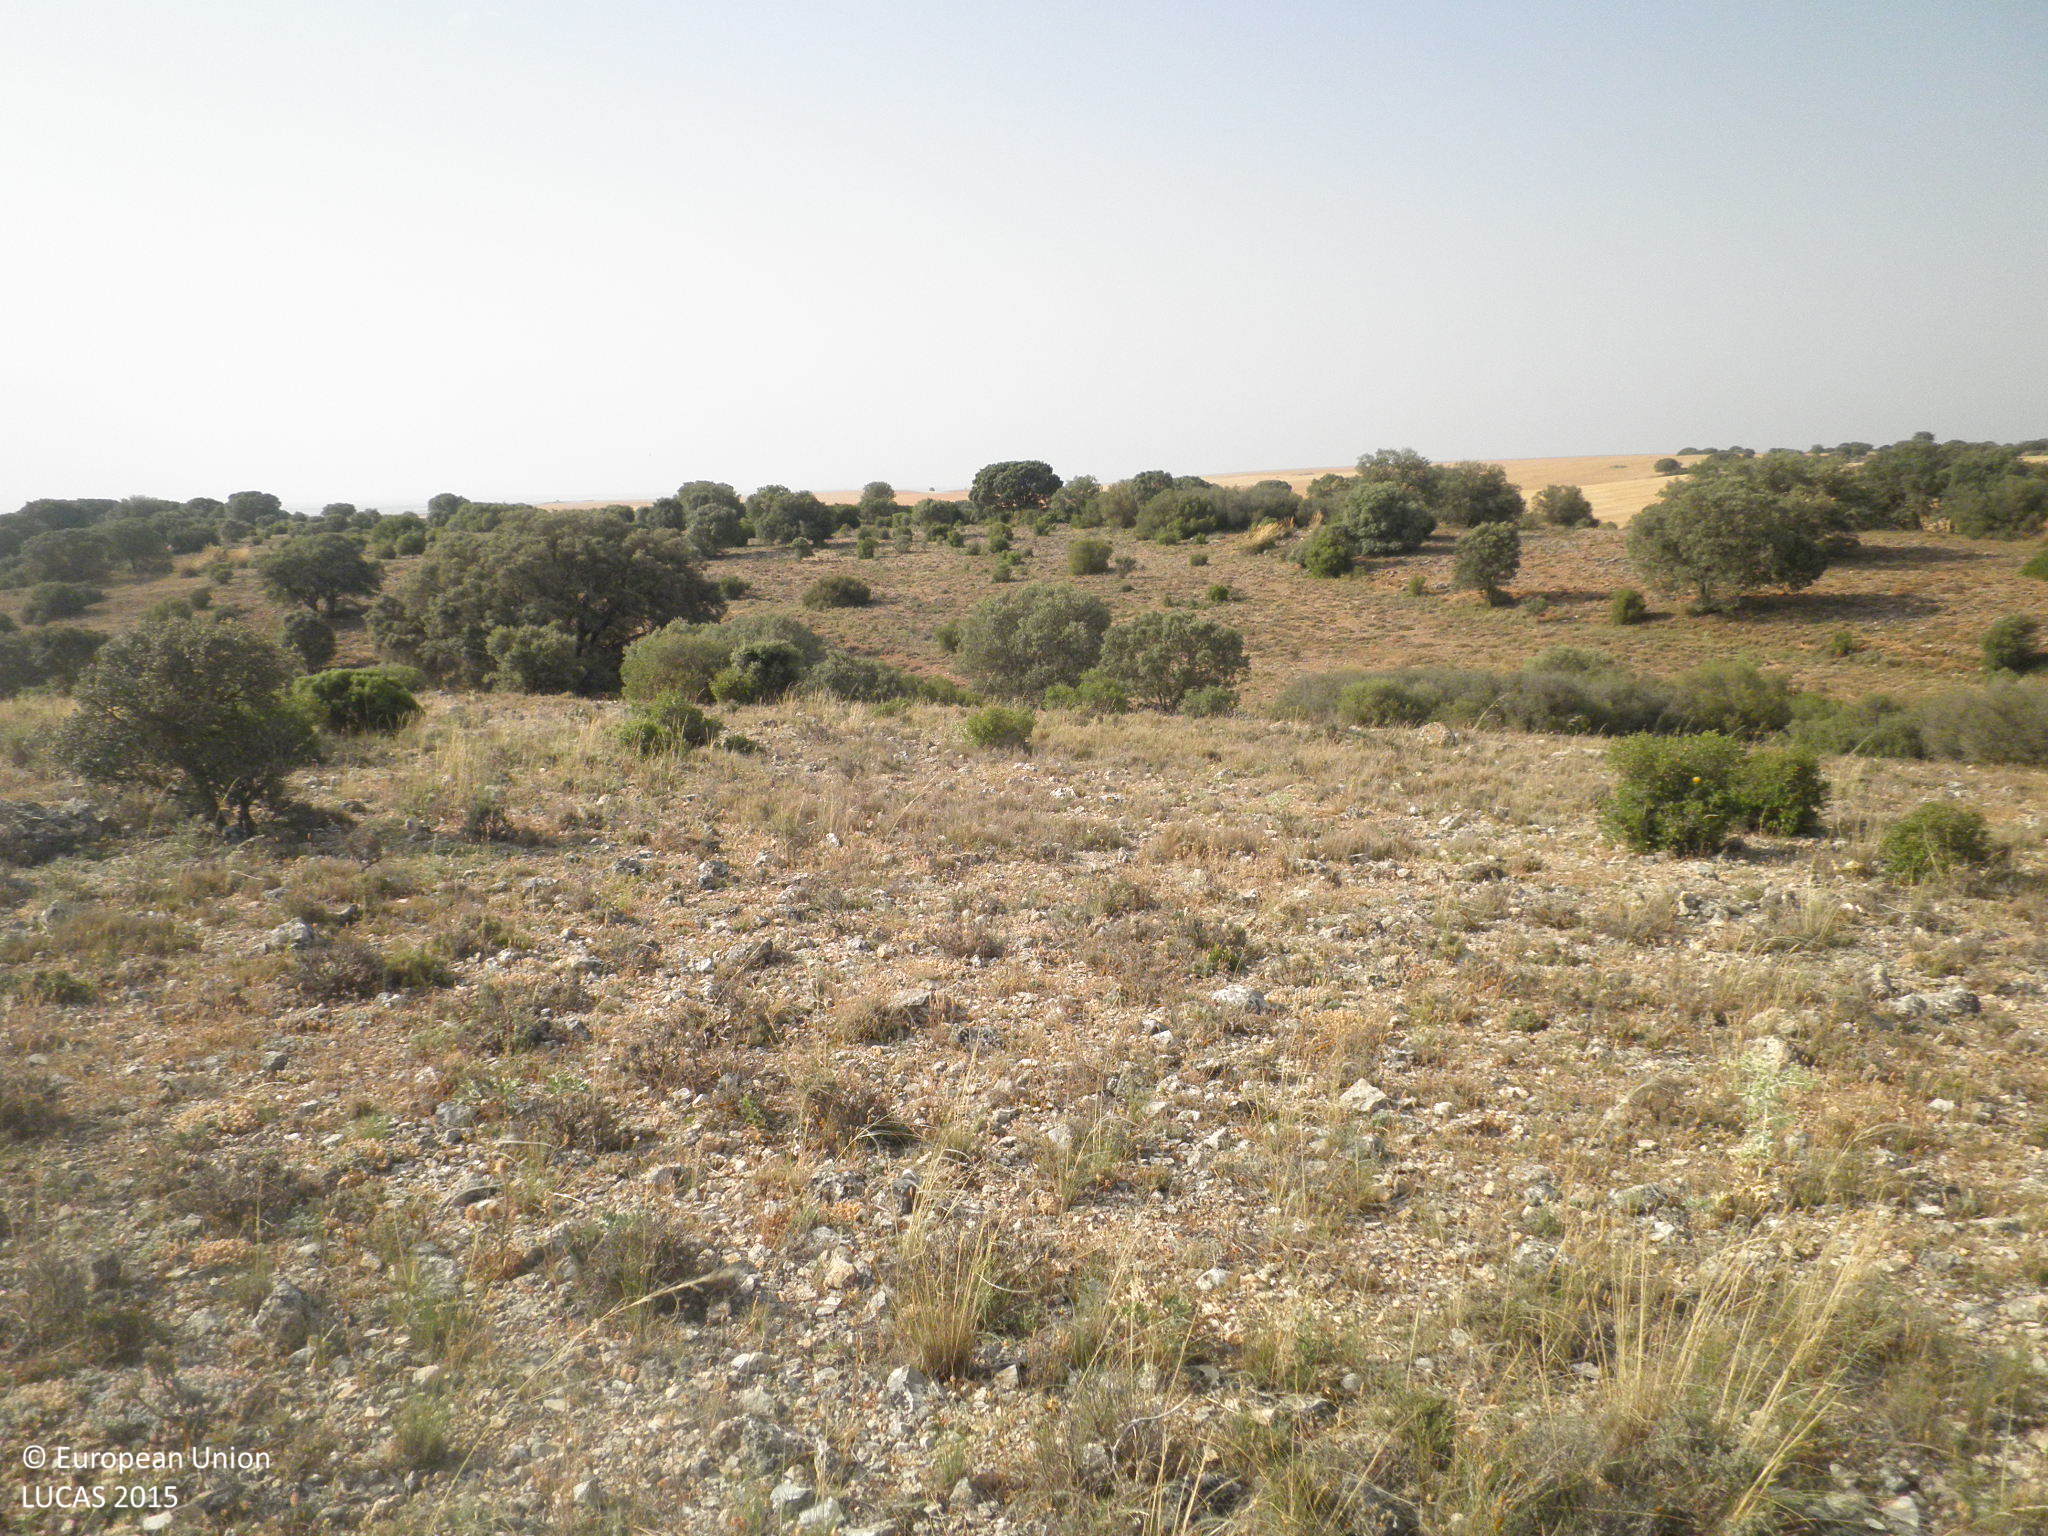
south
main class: Shrubland
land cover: Shrubland with sparse tree cover
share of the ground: 25 - 50 %
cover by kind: unconsolidated bare surface 45 %, shrubs 30 %, herbaceous plants 20 %, broadleaved forest trees 5 %
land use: Semi-natural and natural areas not in use
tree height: < 5 m
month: July
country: ES
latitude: 39.4904
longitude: -2.4411
